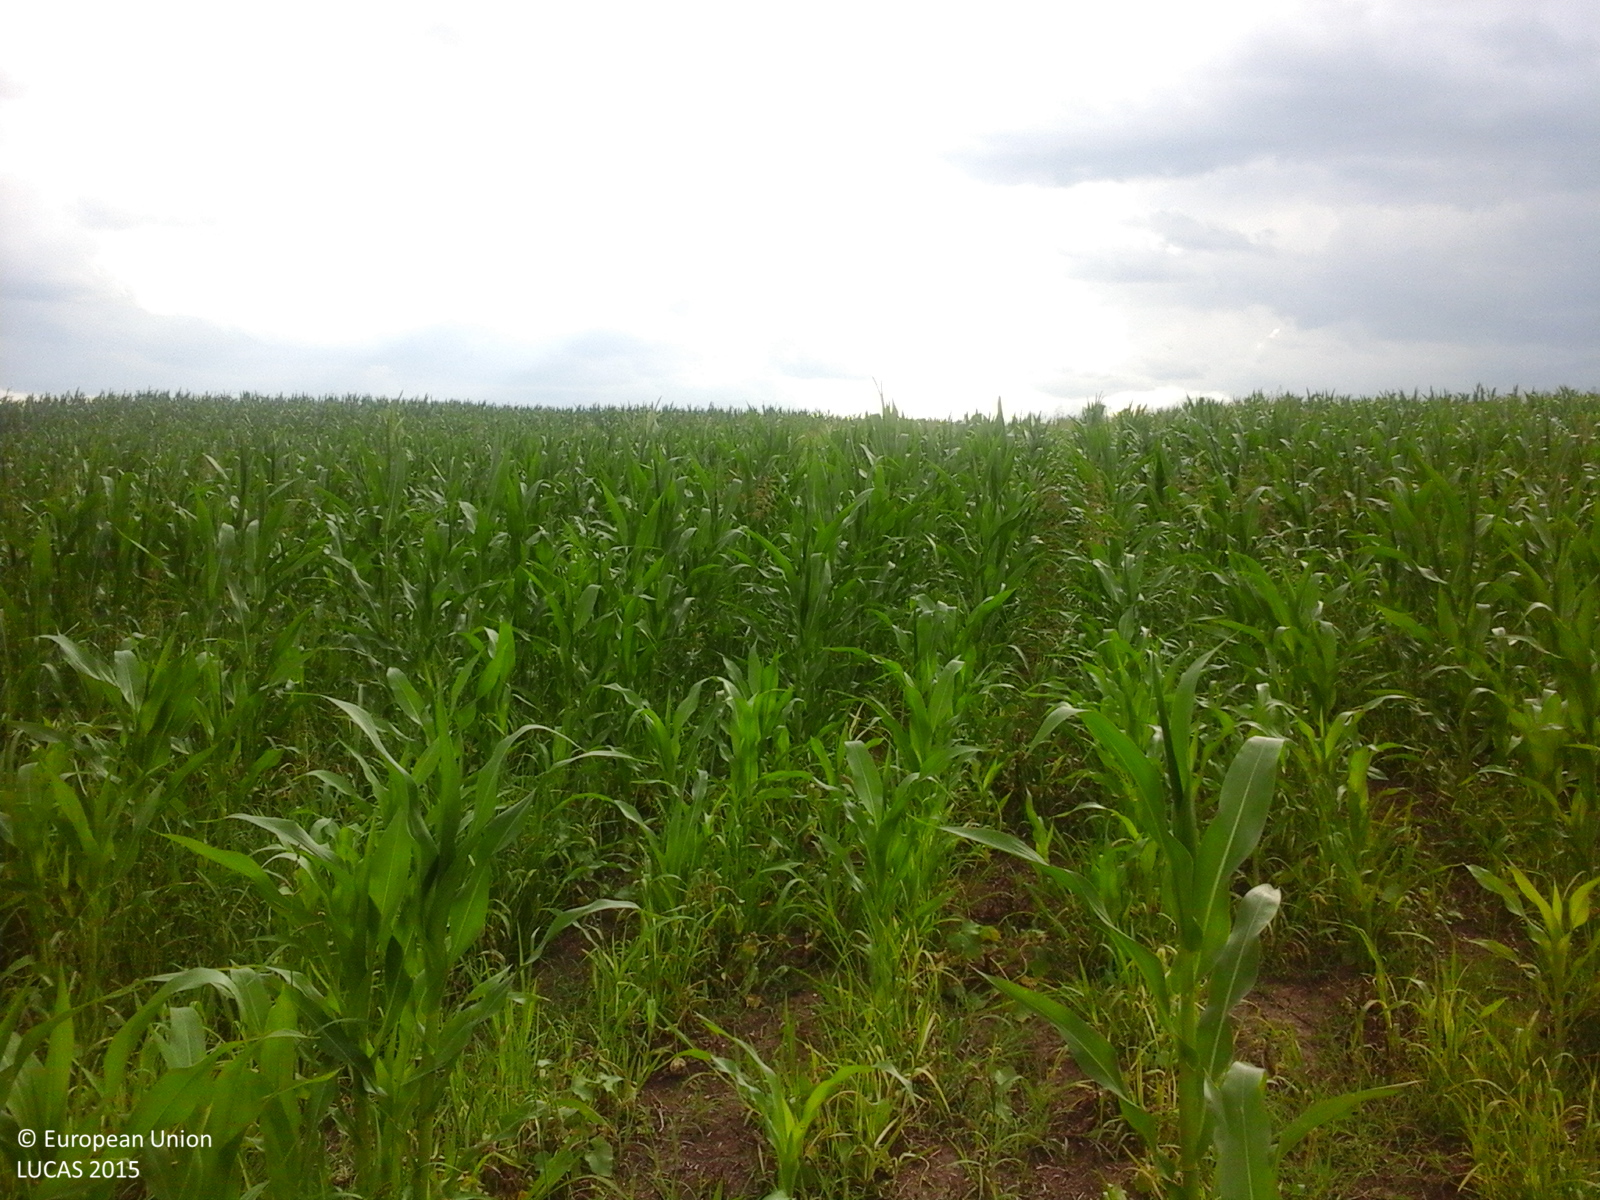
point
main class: Cropland
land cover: Maize
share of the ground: > 75 %
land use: Agriculture (excluding fallow land and kitchen gardens)
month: July
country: RO
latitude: 44.4375
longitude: 24.9163
